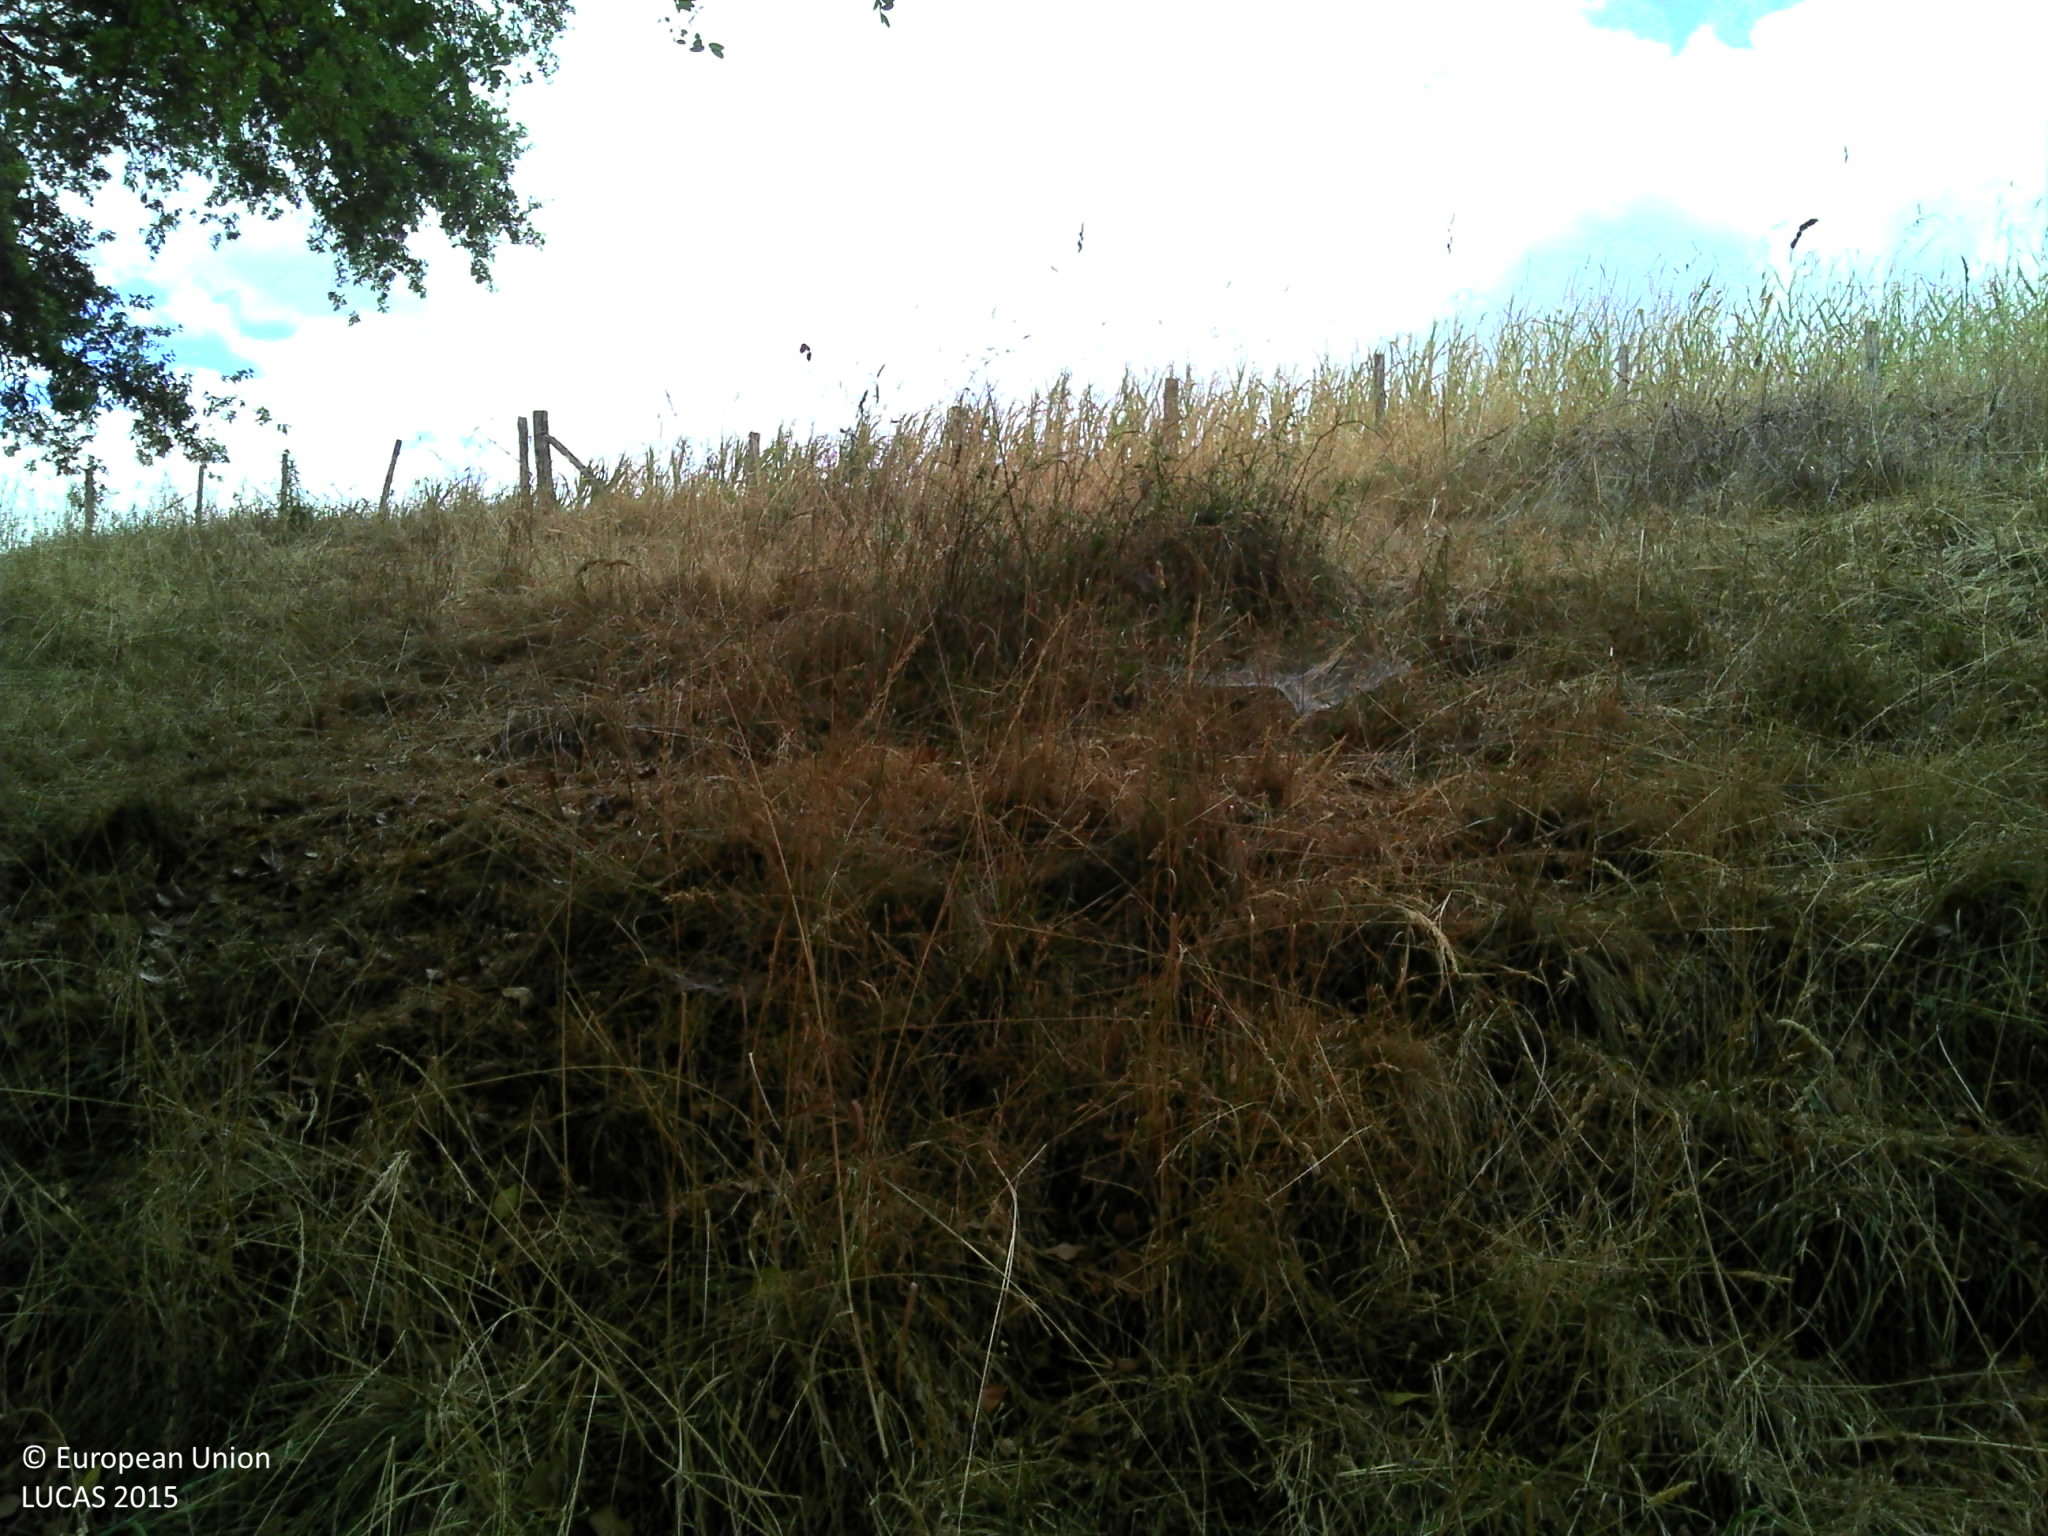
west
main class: Grassland
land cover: Grassland with sparse tree/shrub cover
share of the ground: > 75 %
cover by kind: herbaceous plants 90 %, broadleaved forest trees 5 %, lichens and mosses 5 %
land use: Agriculture (excluding fallow land and kitchen gardens)
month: July
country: FR
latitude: 45.1716
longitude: 1.4059
